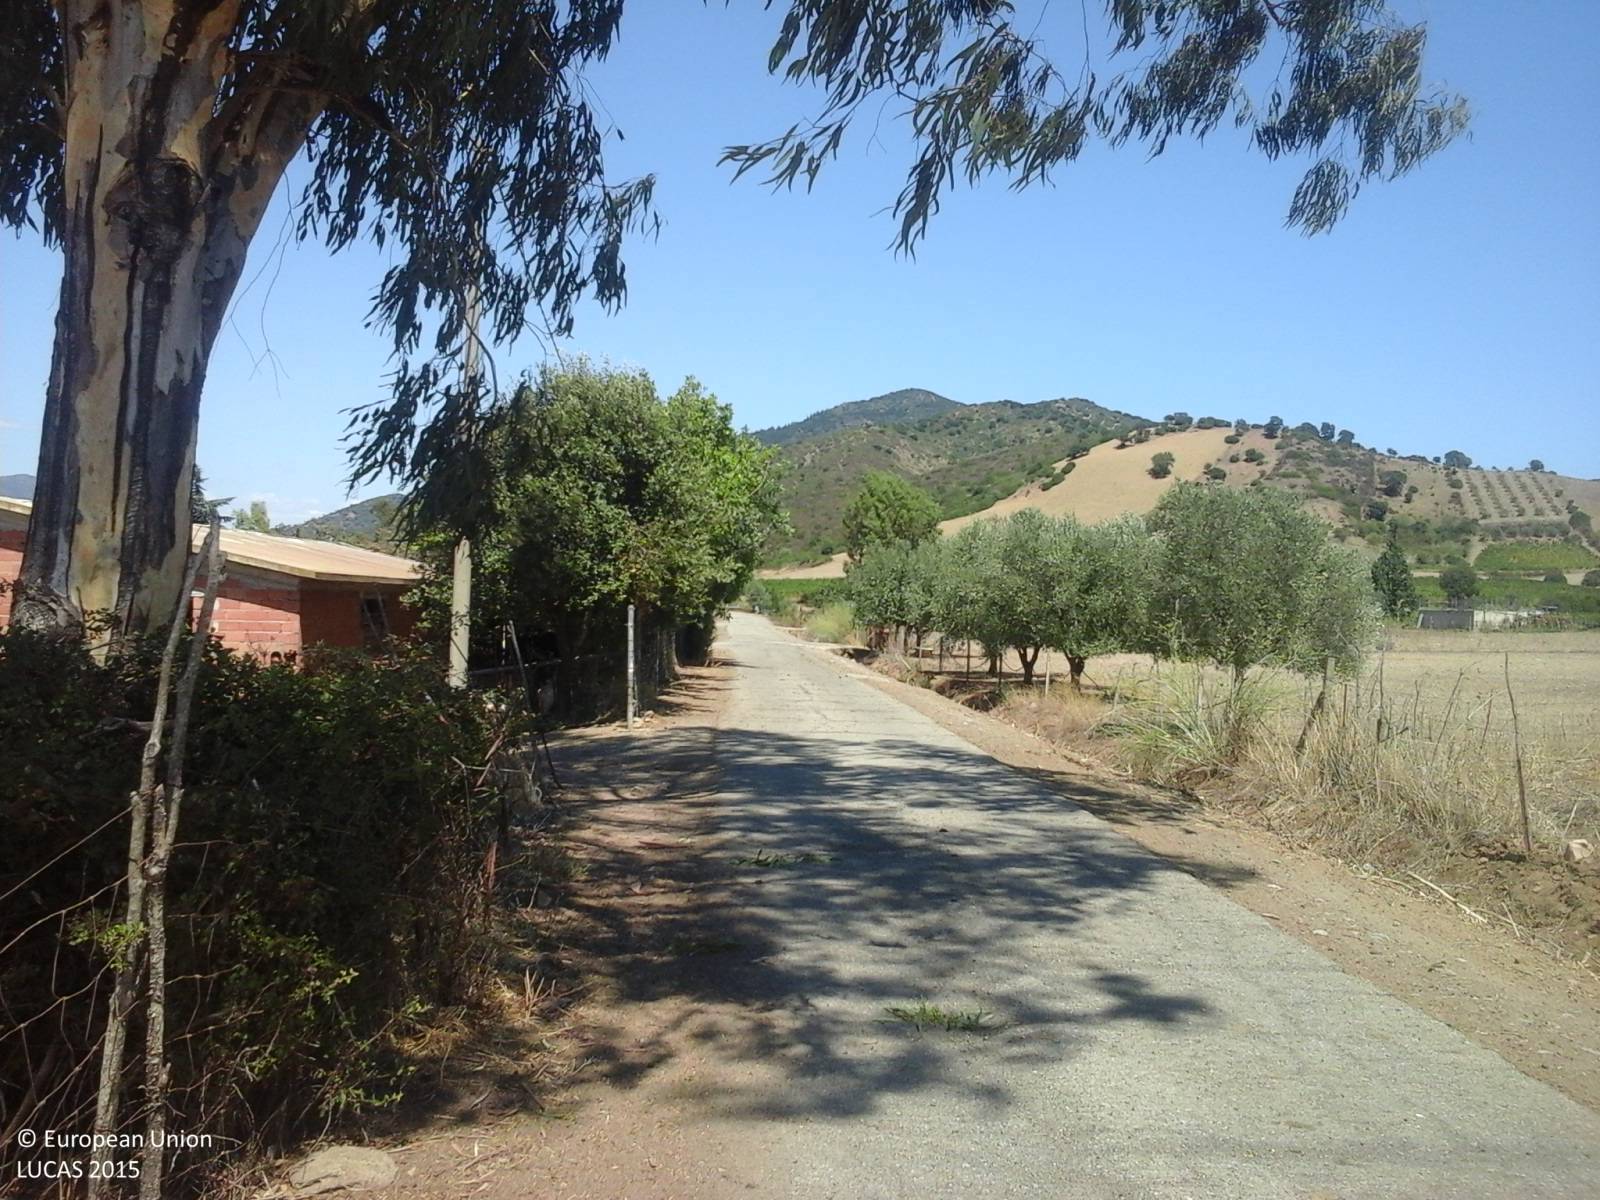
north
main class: Cropland
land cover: Temporary grasslands
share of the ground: 25 - 50 %
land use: Agriculture (excluding fallow land and kitchen gardens)
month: August
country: IT
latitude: 39.6146
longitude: 9.5947
